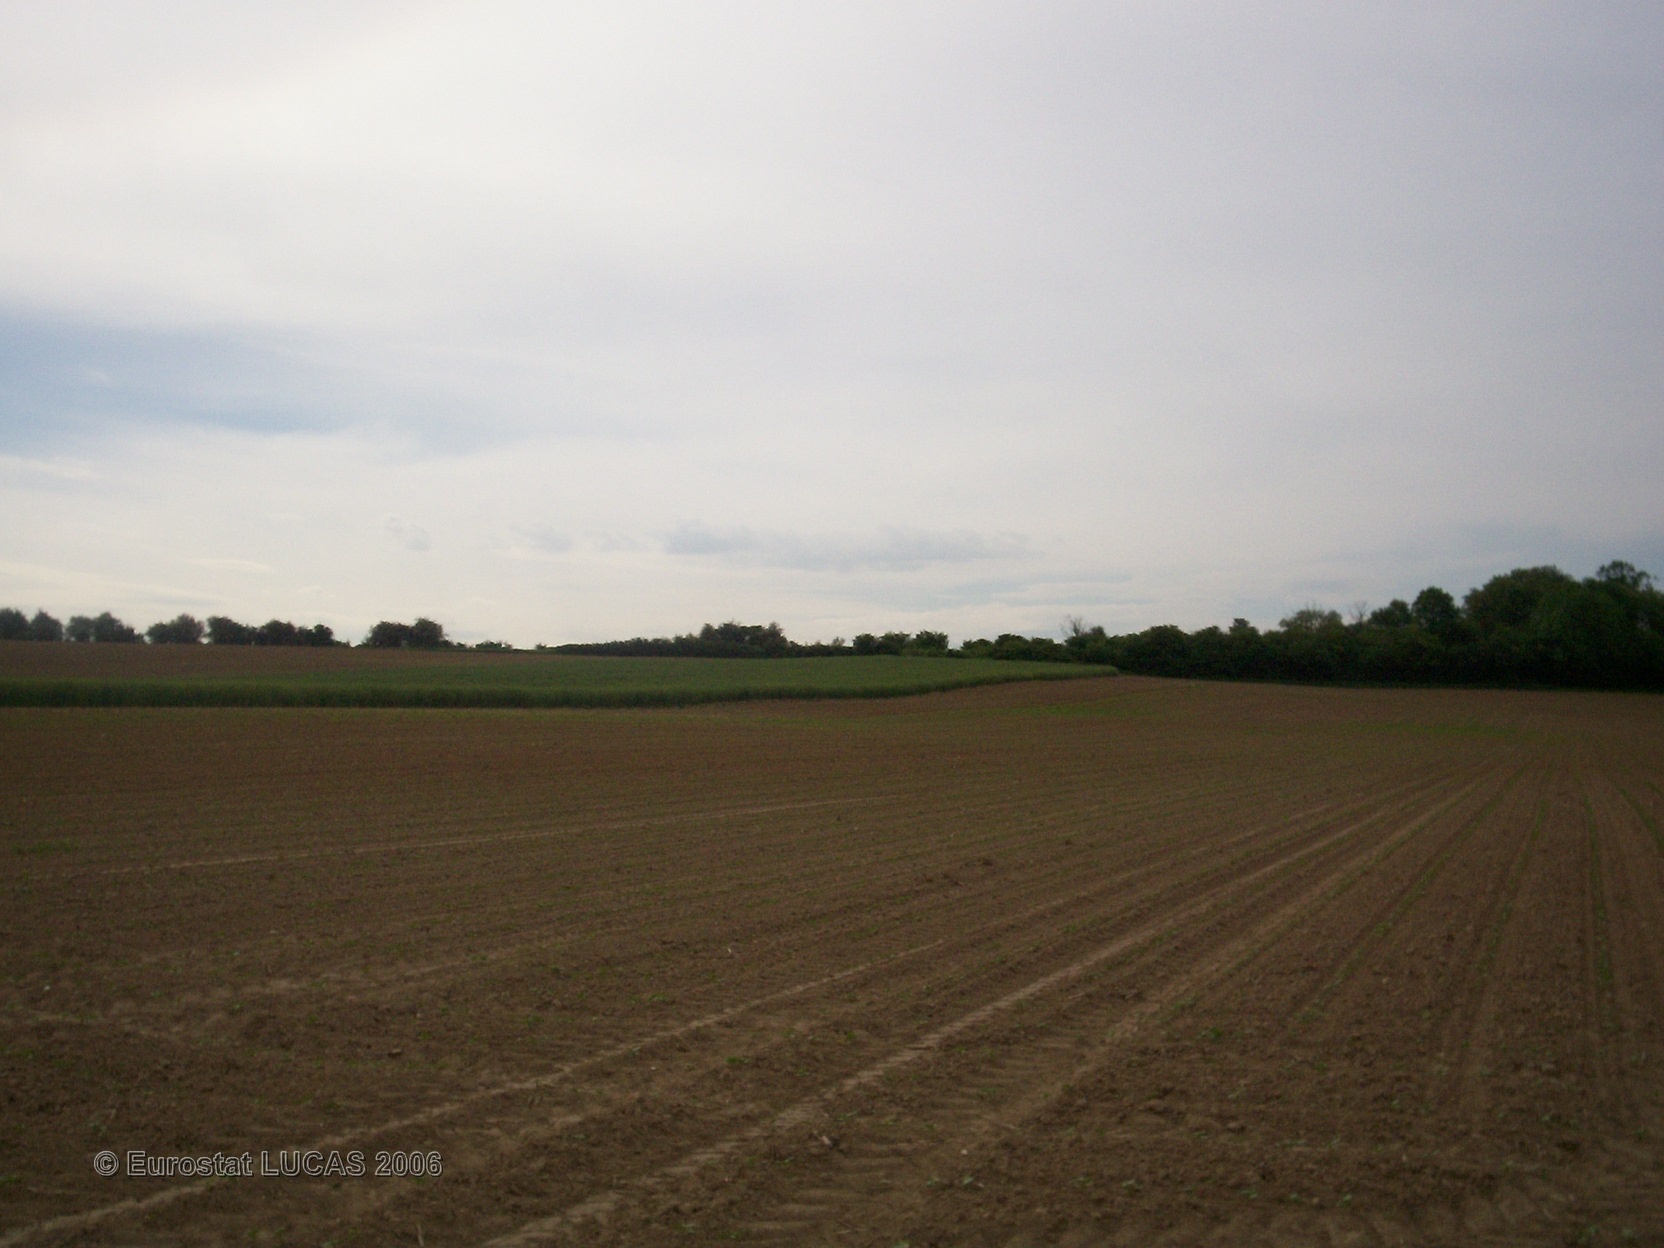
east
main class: Cropland
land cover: Soya
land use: Agriculture (excluding fallow land and kitchen gardens)
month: May
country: FR
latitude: 45.8501
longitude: 4.8910
